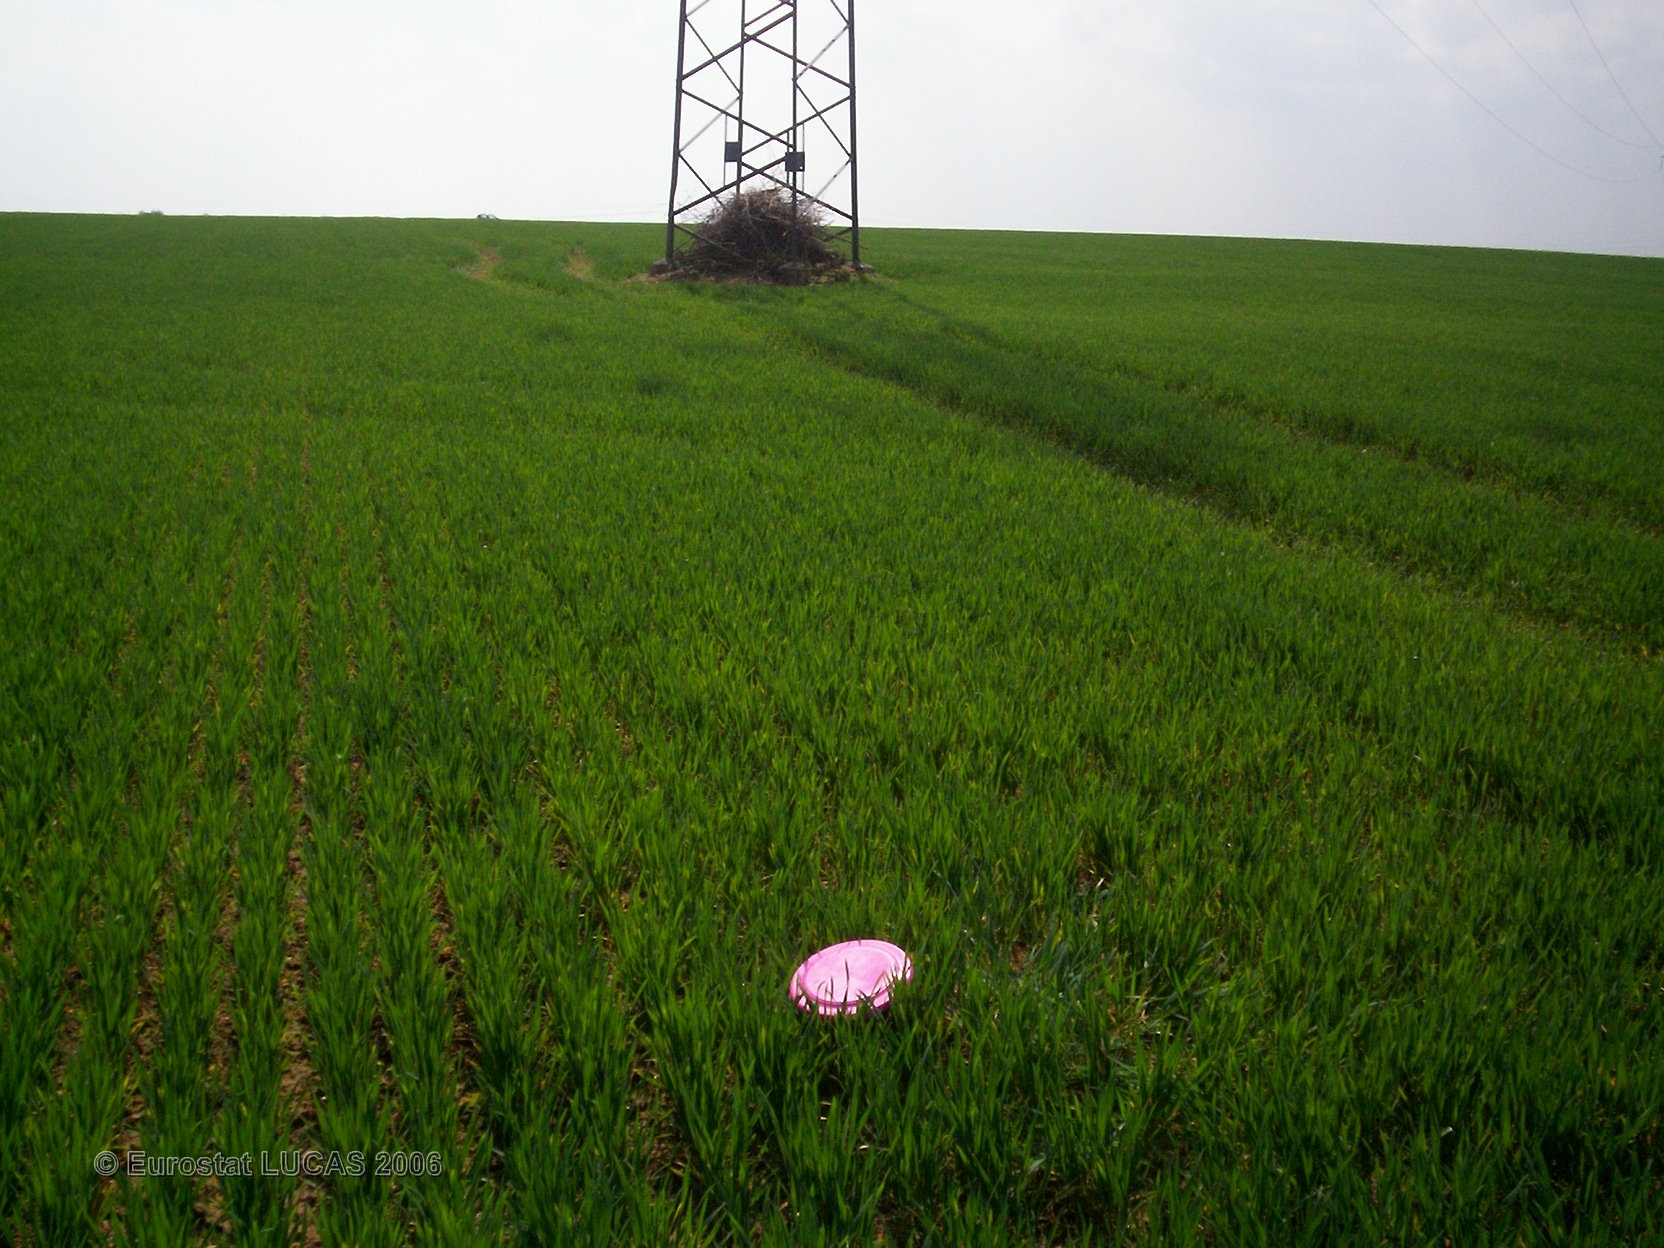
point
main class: Cropland
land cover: Common wheat
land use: Agriculture (excluding fallow land and kitchen gardens)
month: April
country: FR
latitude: 48.8678
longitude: 5.8961
